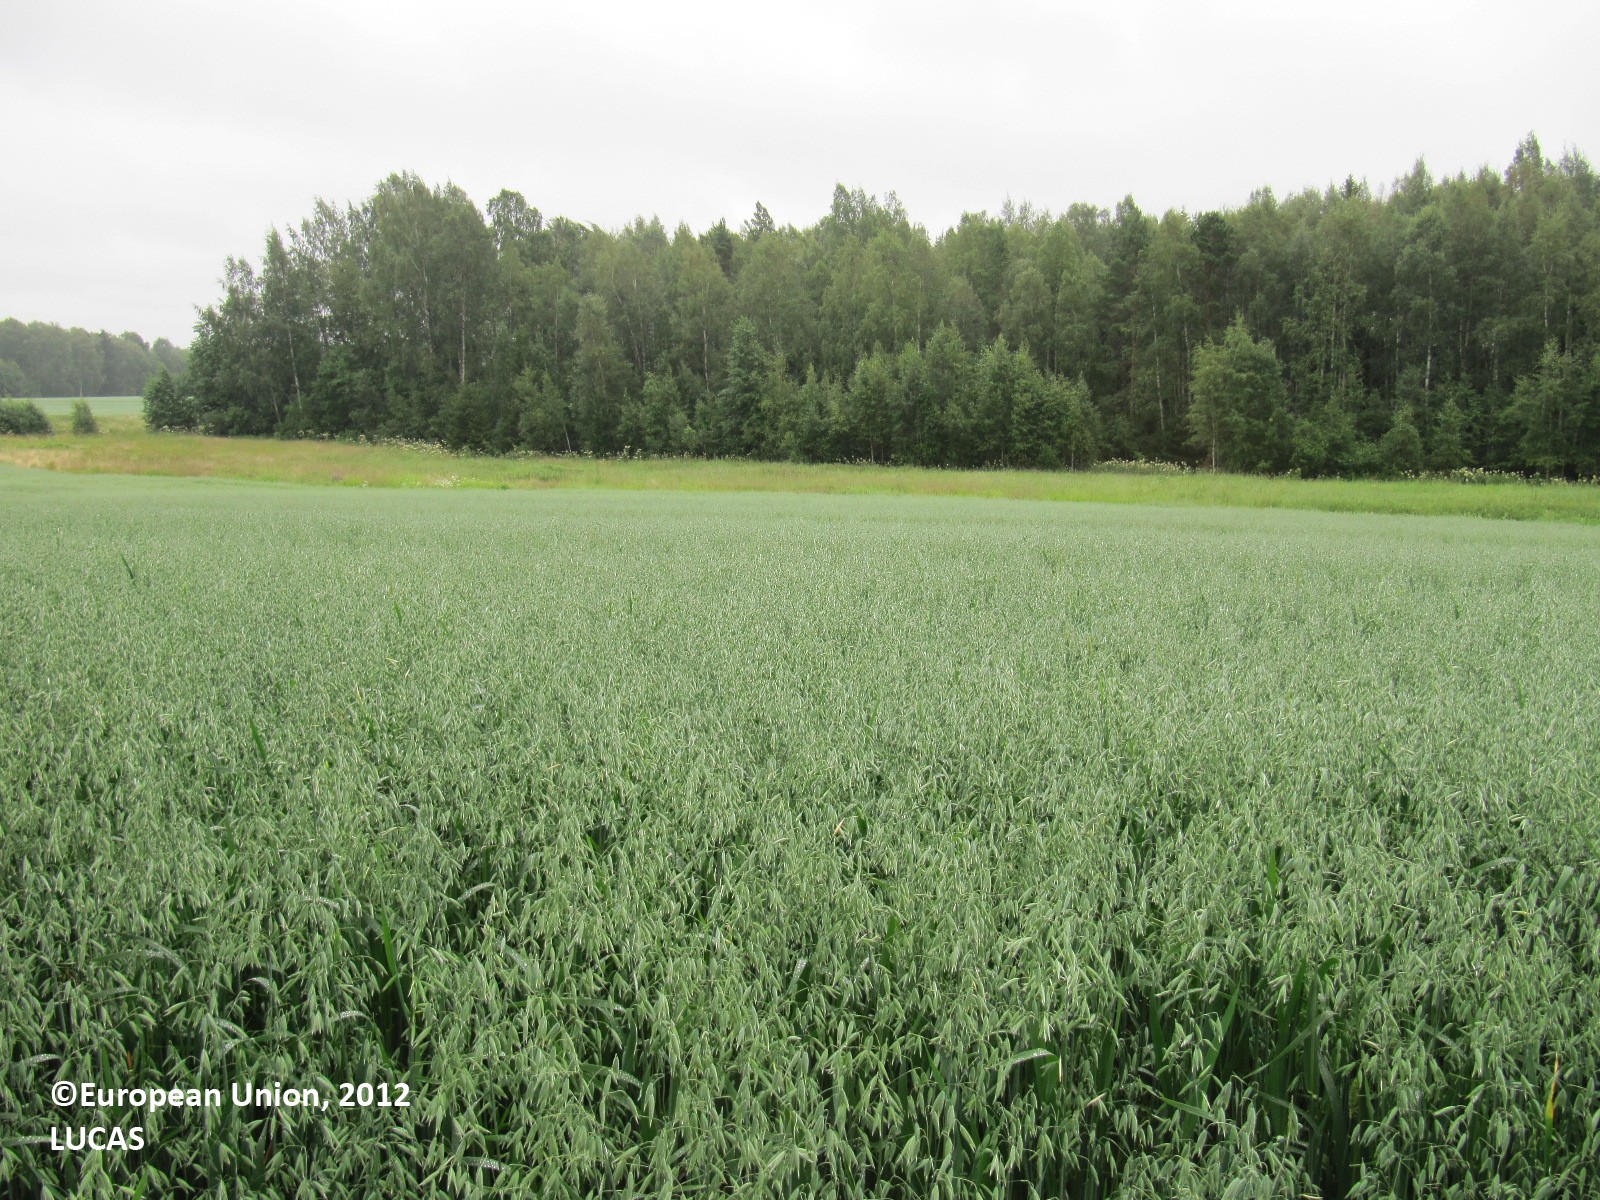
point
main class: Cropland
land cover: Oats
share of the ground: > 75 %
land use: Agriculture (excluding fallow land and kitchen gardens)
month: July
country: FI
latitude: 60.3046
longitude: 23.7927
